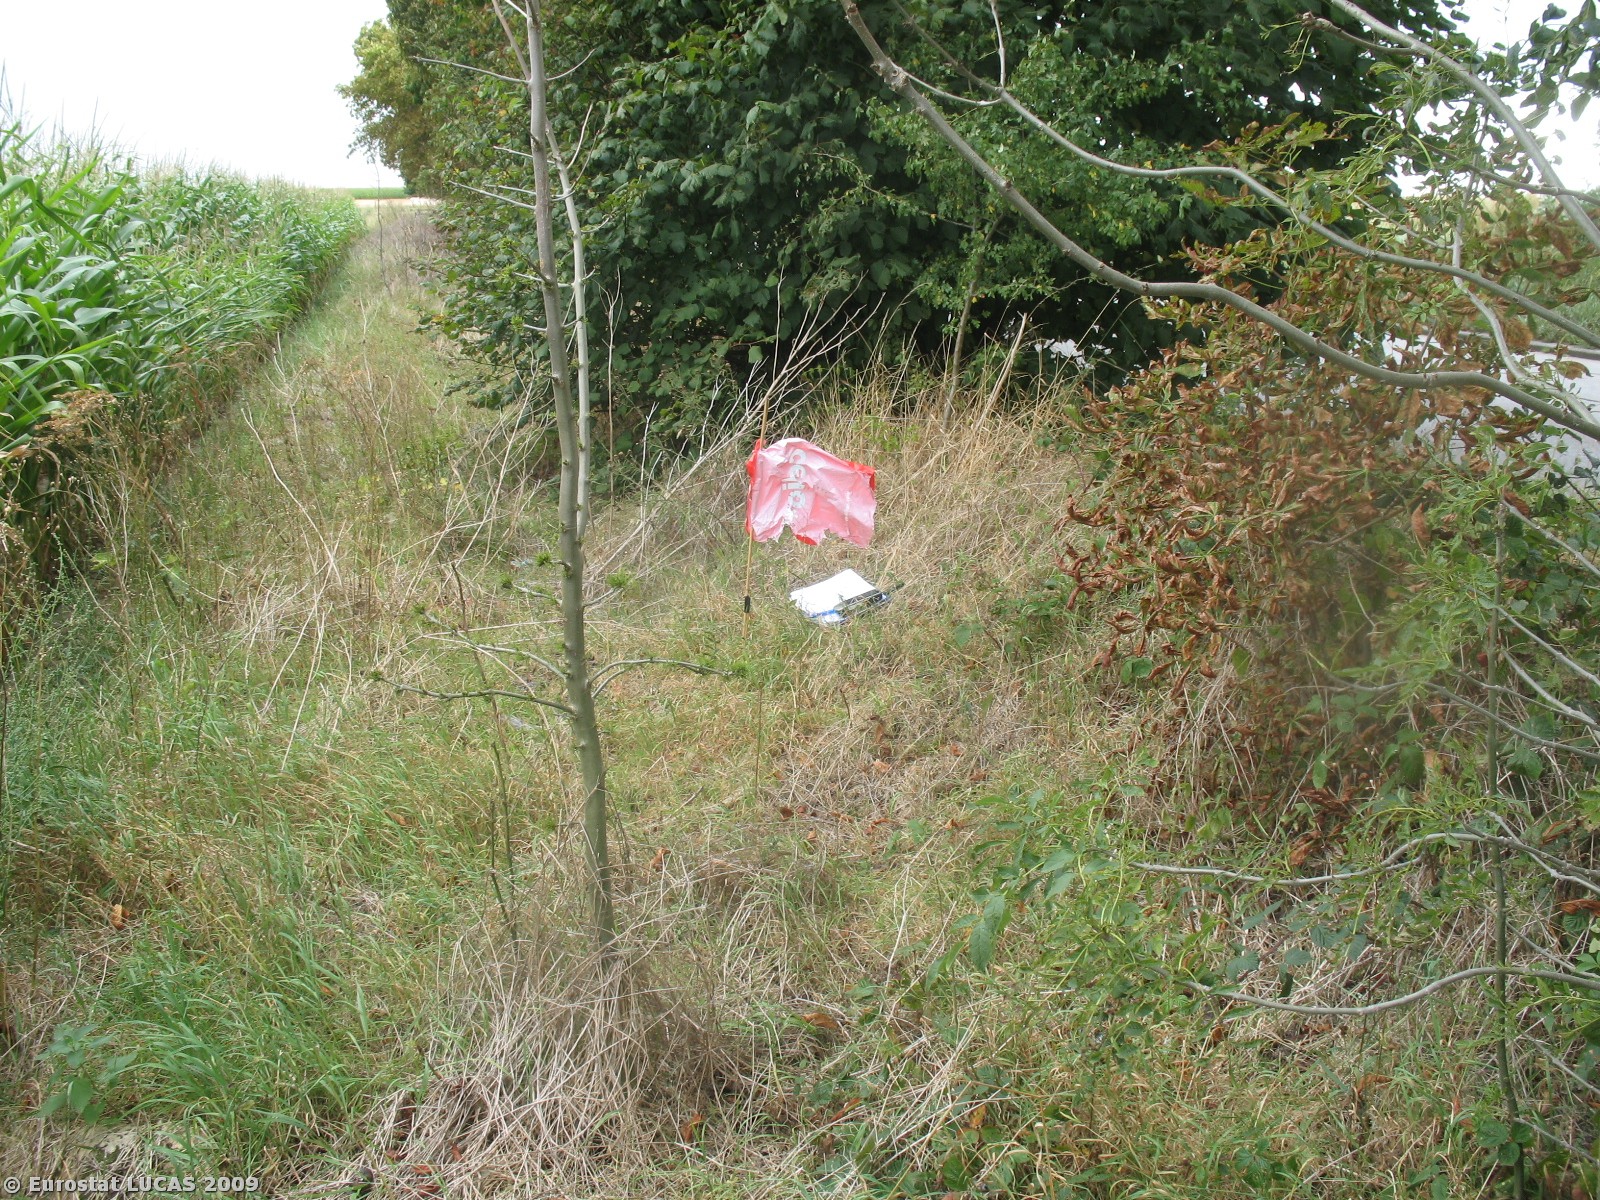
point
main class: Woodland
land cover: Broadleaved woodland
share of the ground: 50 - 75 %
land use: Unused
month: August
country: BE
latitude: 50.4945
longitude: 4.3426
